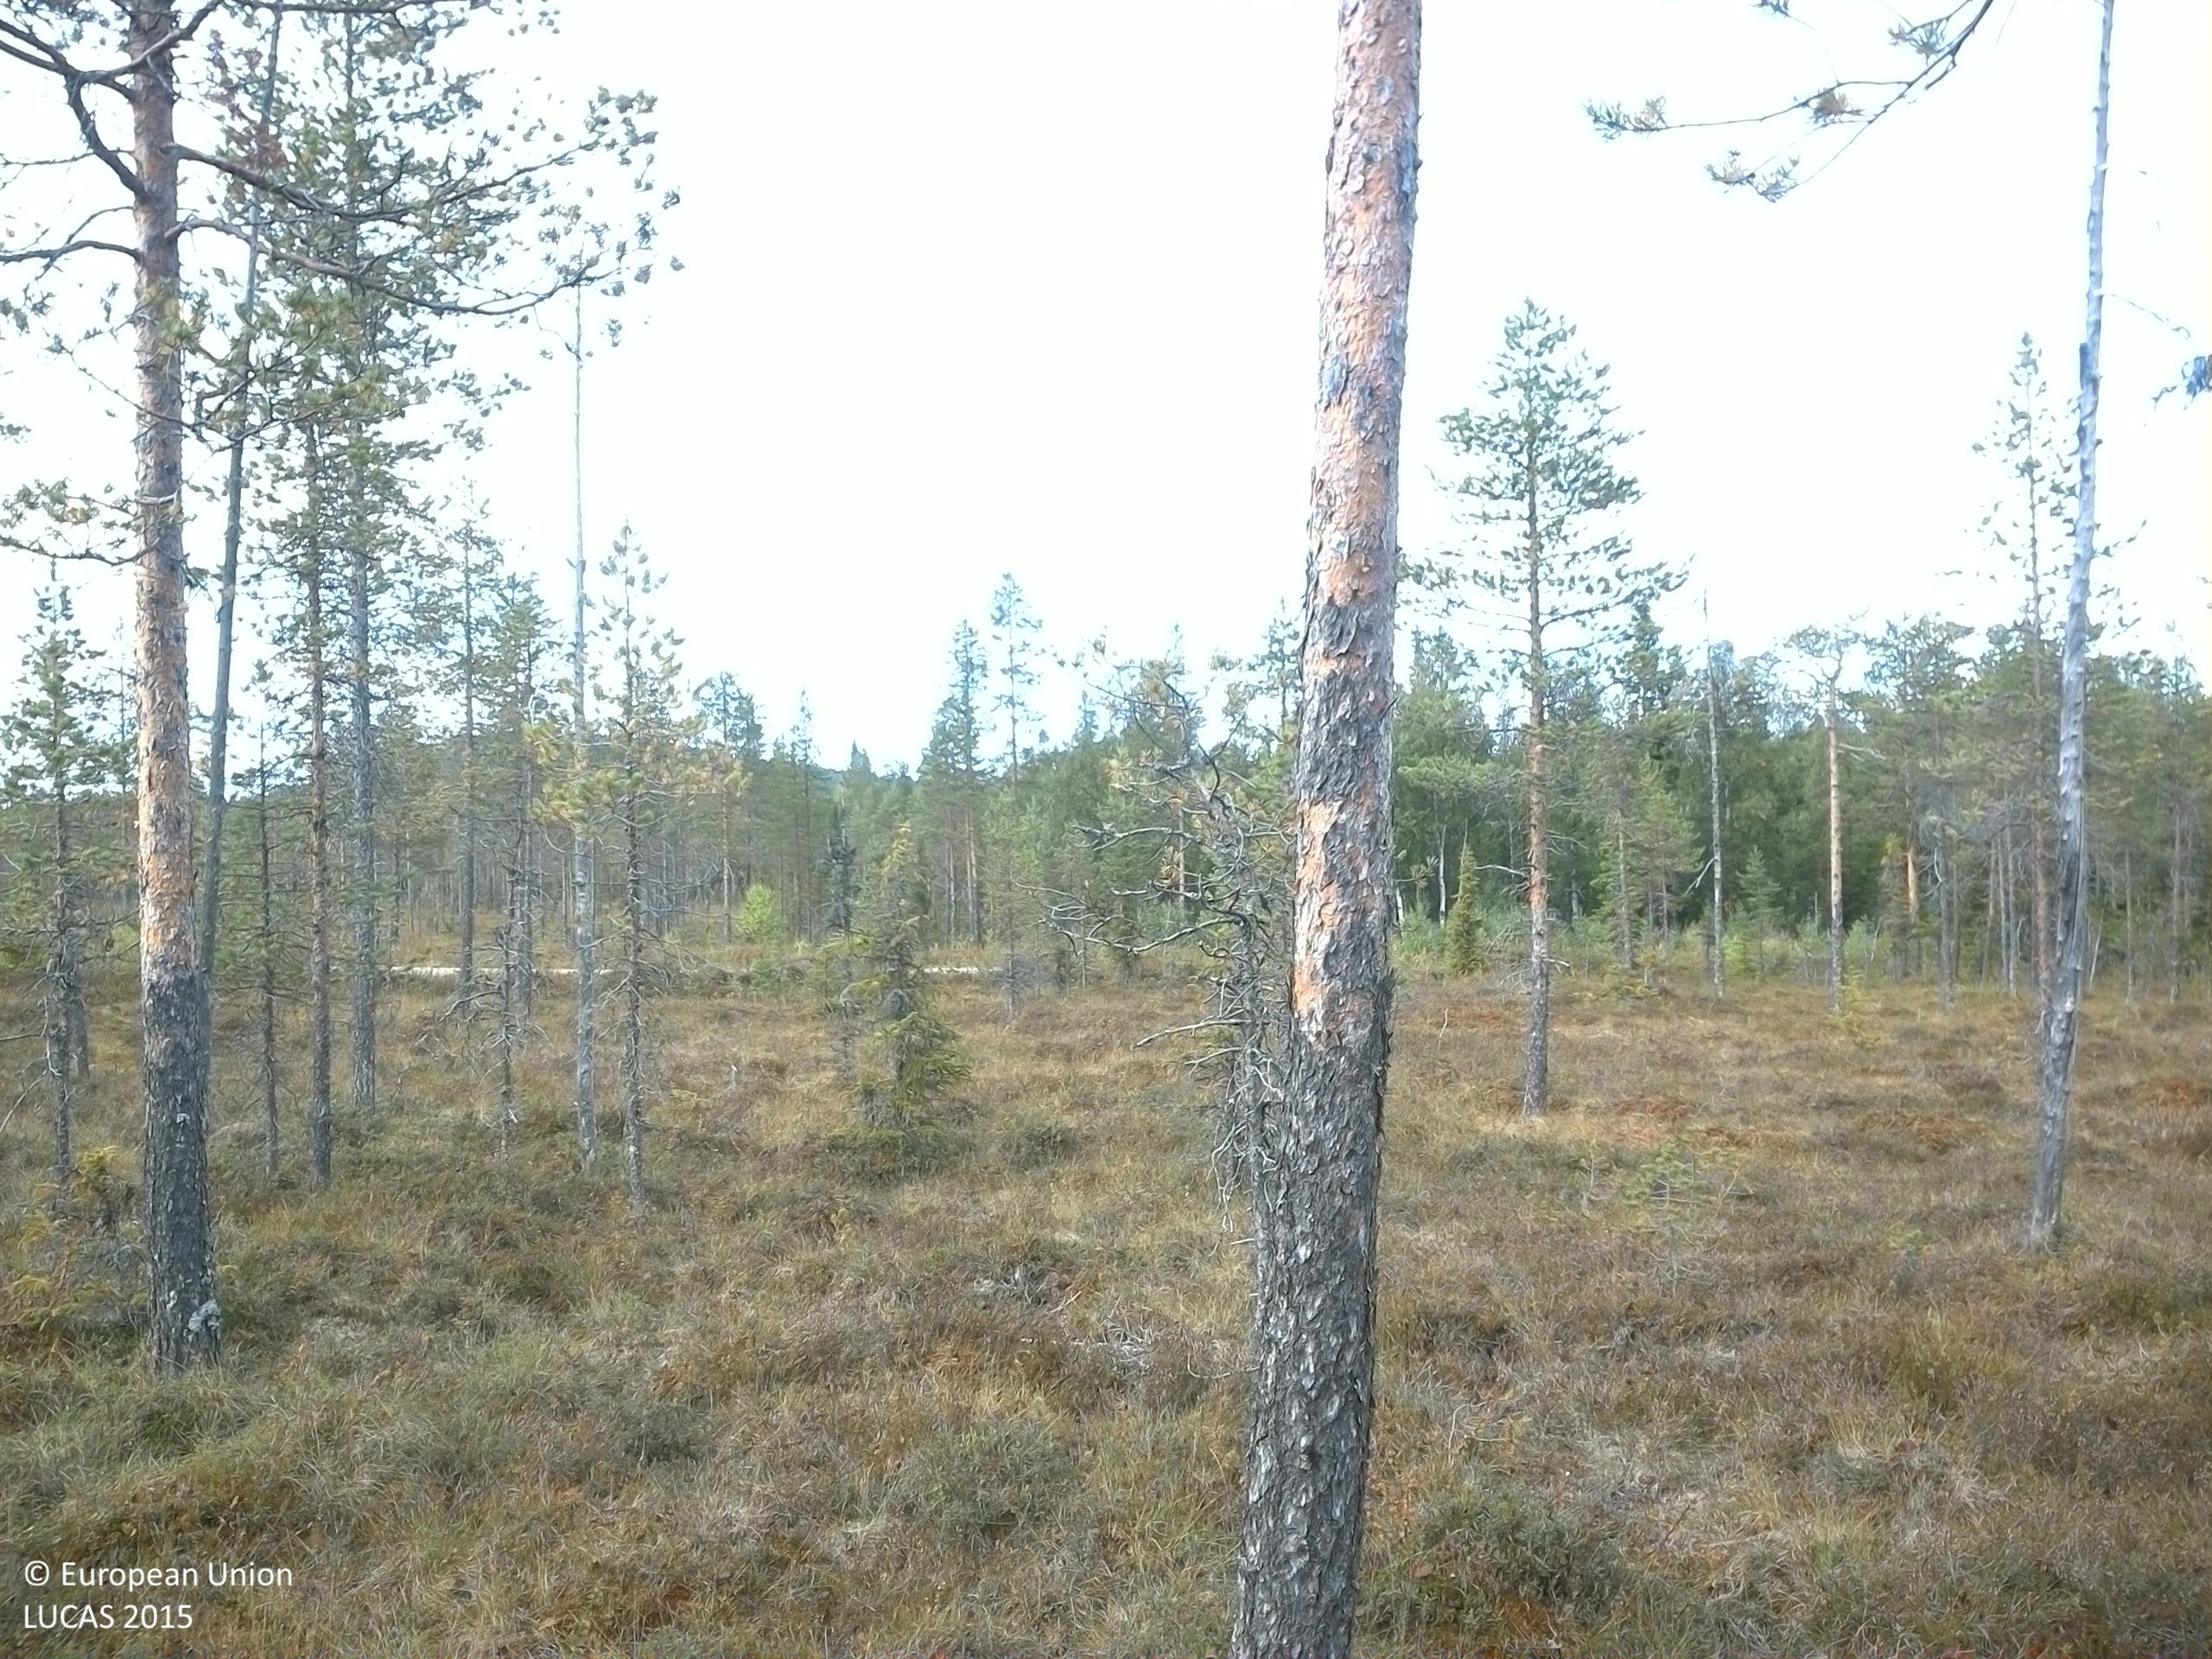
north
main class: Woodland
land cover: Pine dominated coniferous woodland
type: boreal forest
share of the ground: 10 - 25 %
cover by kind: lichens and mosses 40 %, shrubs 30 %, coniferous forest trees 20 %, herbaceous plants 10 %
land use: Semi-natural and natural areas not in use
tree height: > 5 m
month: September
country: SE
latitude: 64.0302
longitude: 17.6870
